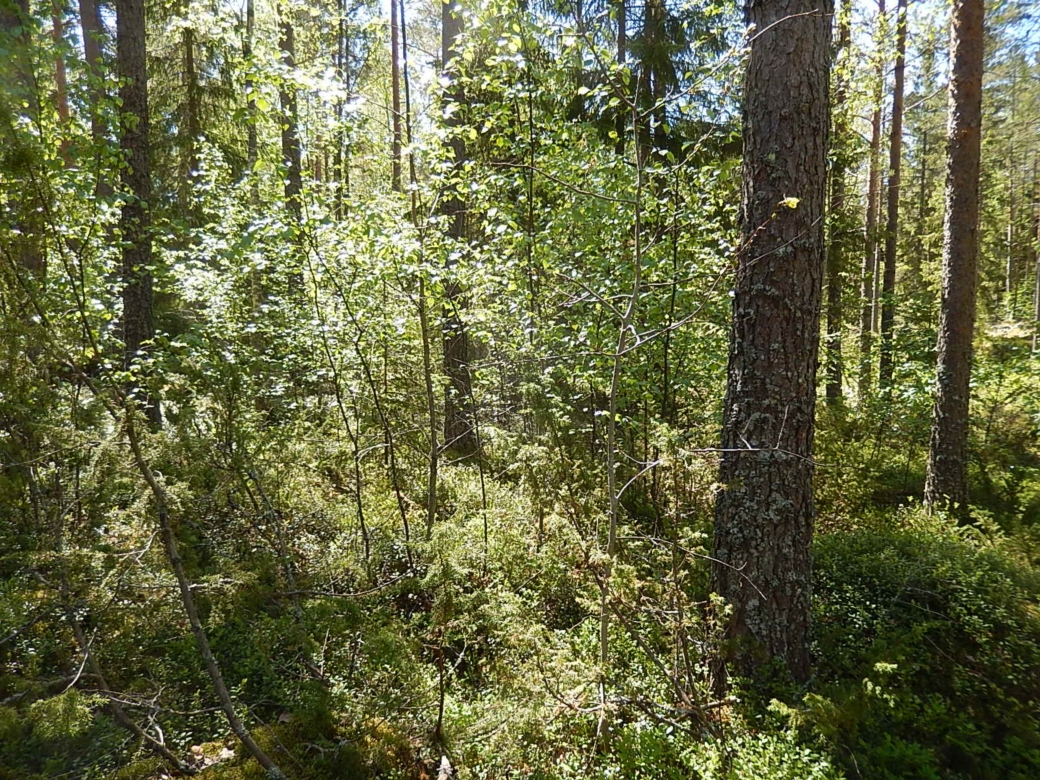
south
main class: Woodland
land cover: Pine dominated mixed woodland
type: boreal forest
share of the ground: 50 - 75 %
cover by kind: coniferous forest trees 50 %, broadleaved forest trees 20 %, shrubs 20 %, lichens and mosses 10 %
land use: Forestry
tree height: > 5 m
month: June
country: FI
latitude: 62.0751
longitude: 21.5507
